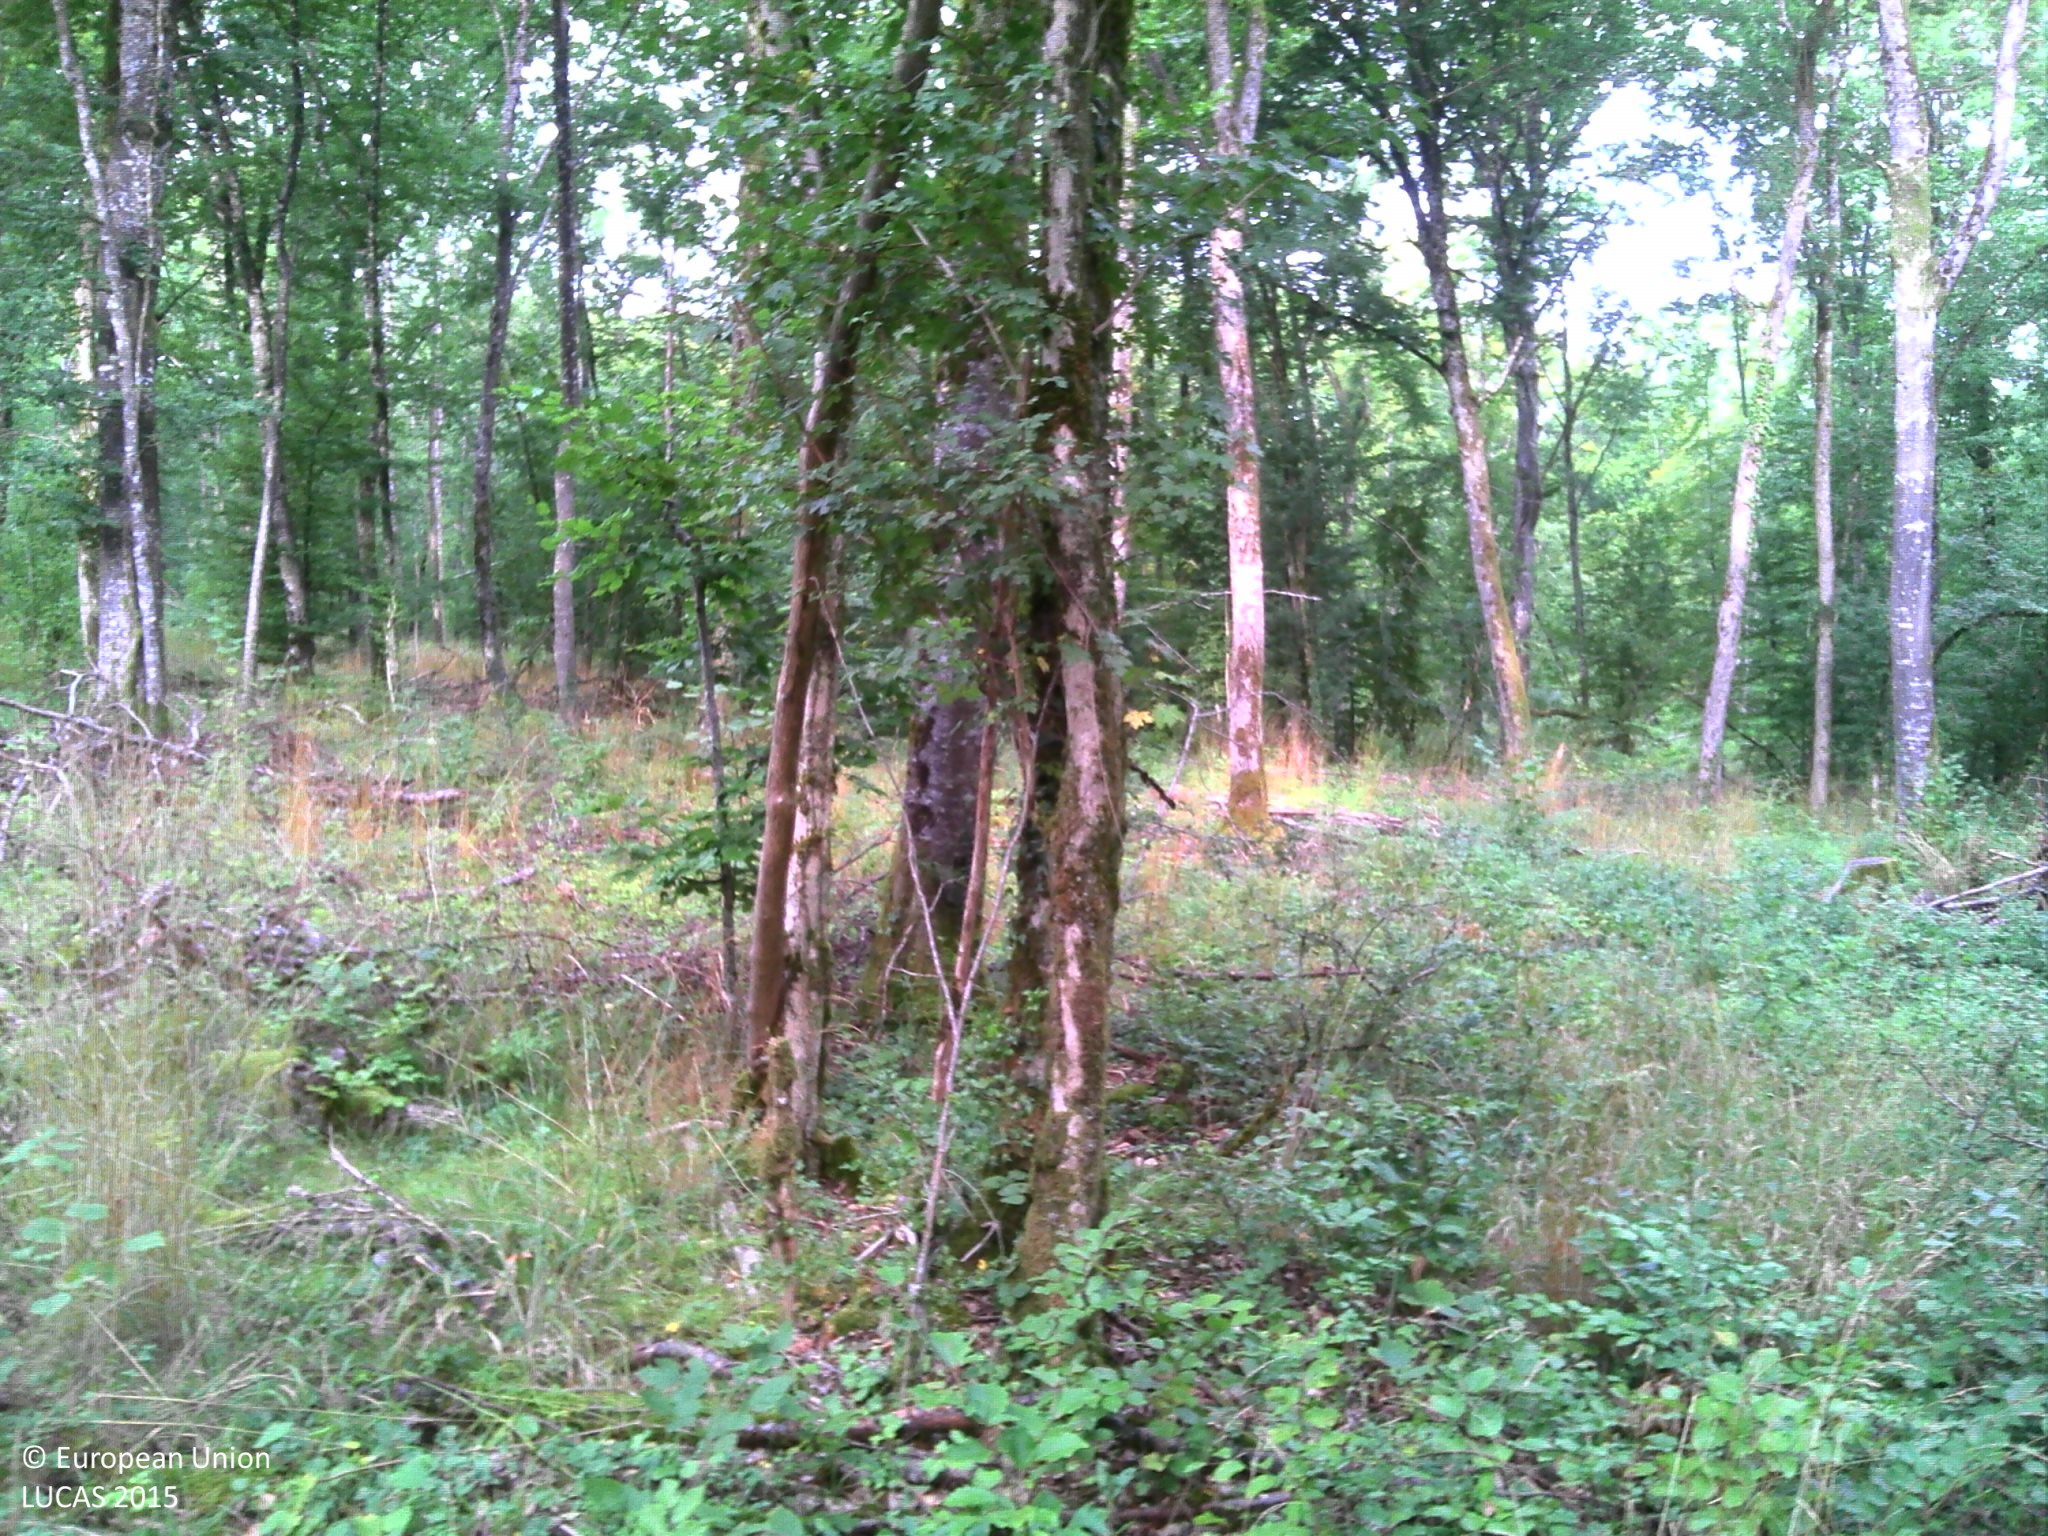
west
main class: Woodland
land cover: Broadleaved woodland
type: mesophytic deciduous forest
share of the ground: > 75 %
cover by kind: broadleaved forest trees 90 %, herbaceous plants 5 %, lichens and mosses 5 %
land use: Forestry
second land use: Amenities, museums, leisure
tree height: > 5 m
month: September
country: FR
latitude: 47.6343
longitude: 4.8489
